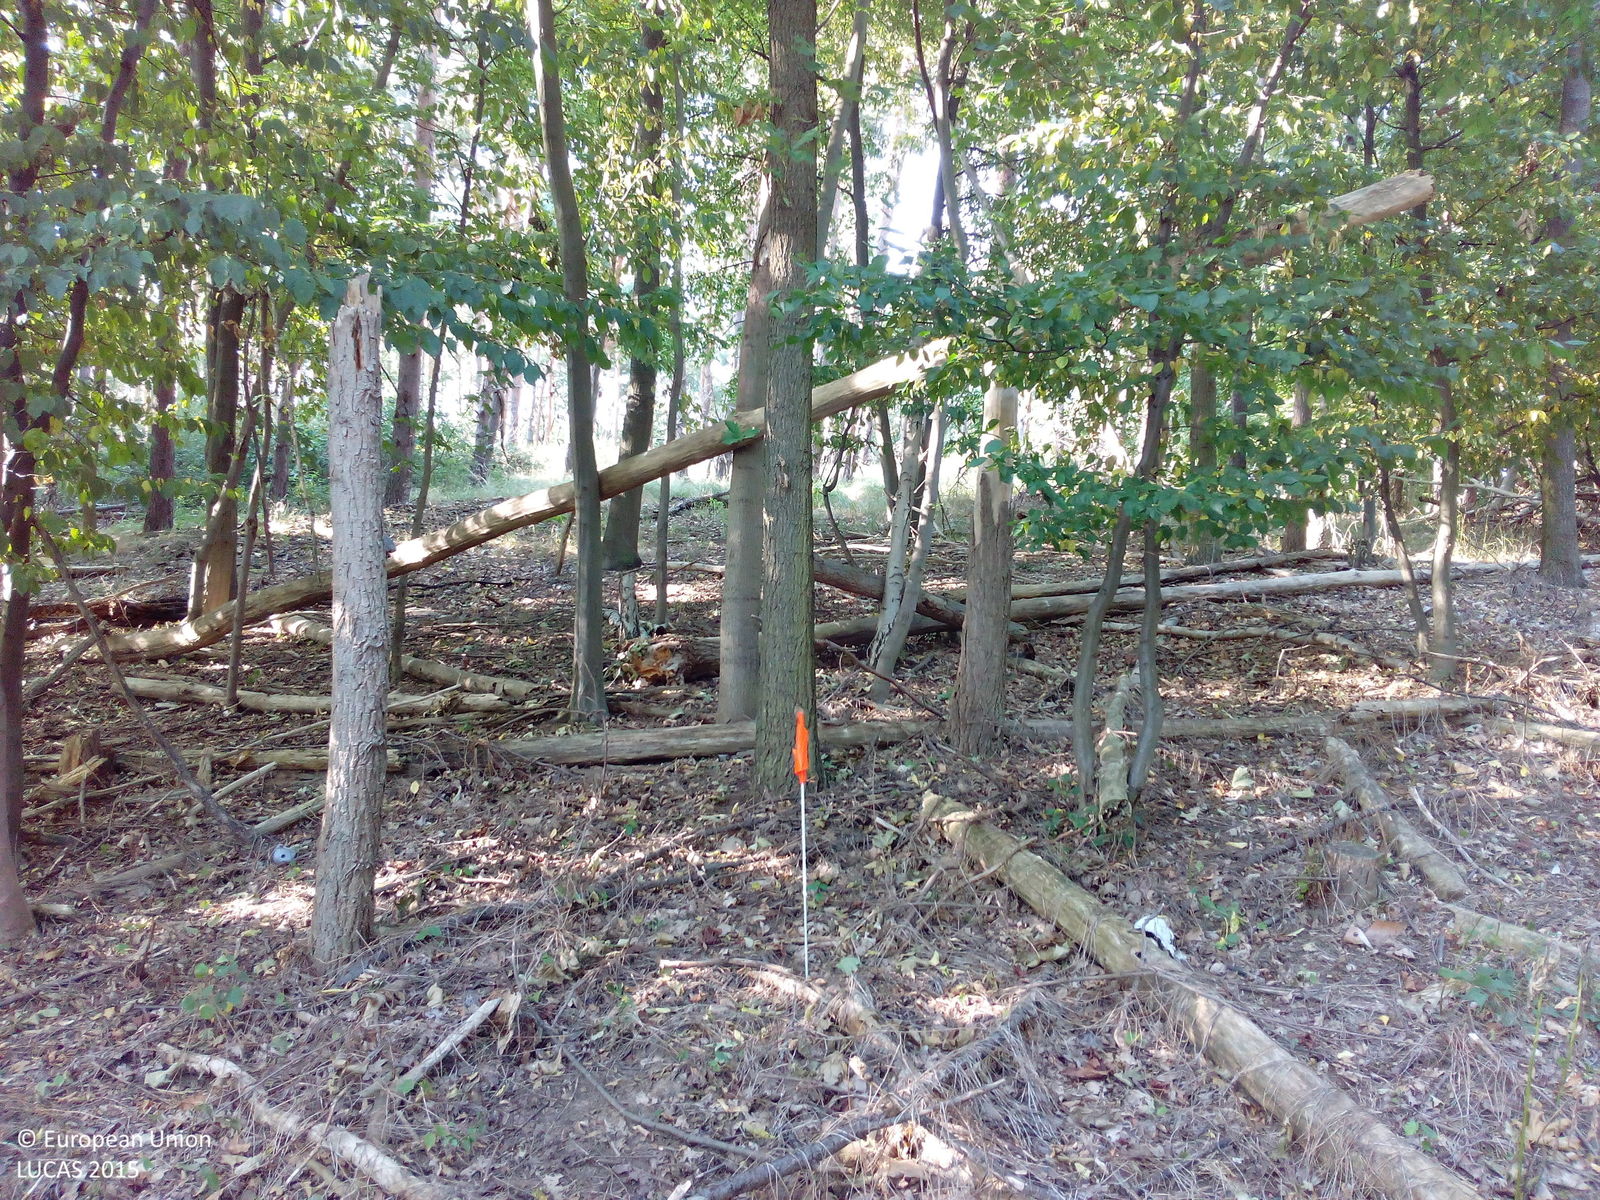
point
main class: Woodland
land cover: Broadleaved woodland
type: beech forest
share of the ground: > 75 %
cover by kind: broadleaved forest trees 90 %, shrubs 5 %, unconsolidated bare surface 5 %
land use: Forestry
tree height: > 5 m
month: August
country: DE
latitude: 51.8509
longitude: 11.1175
